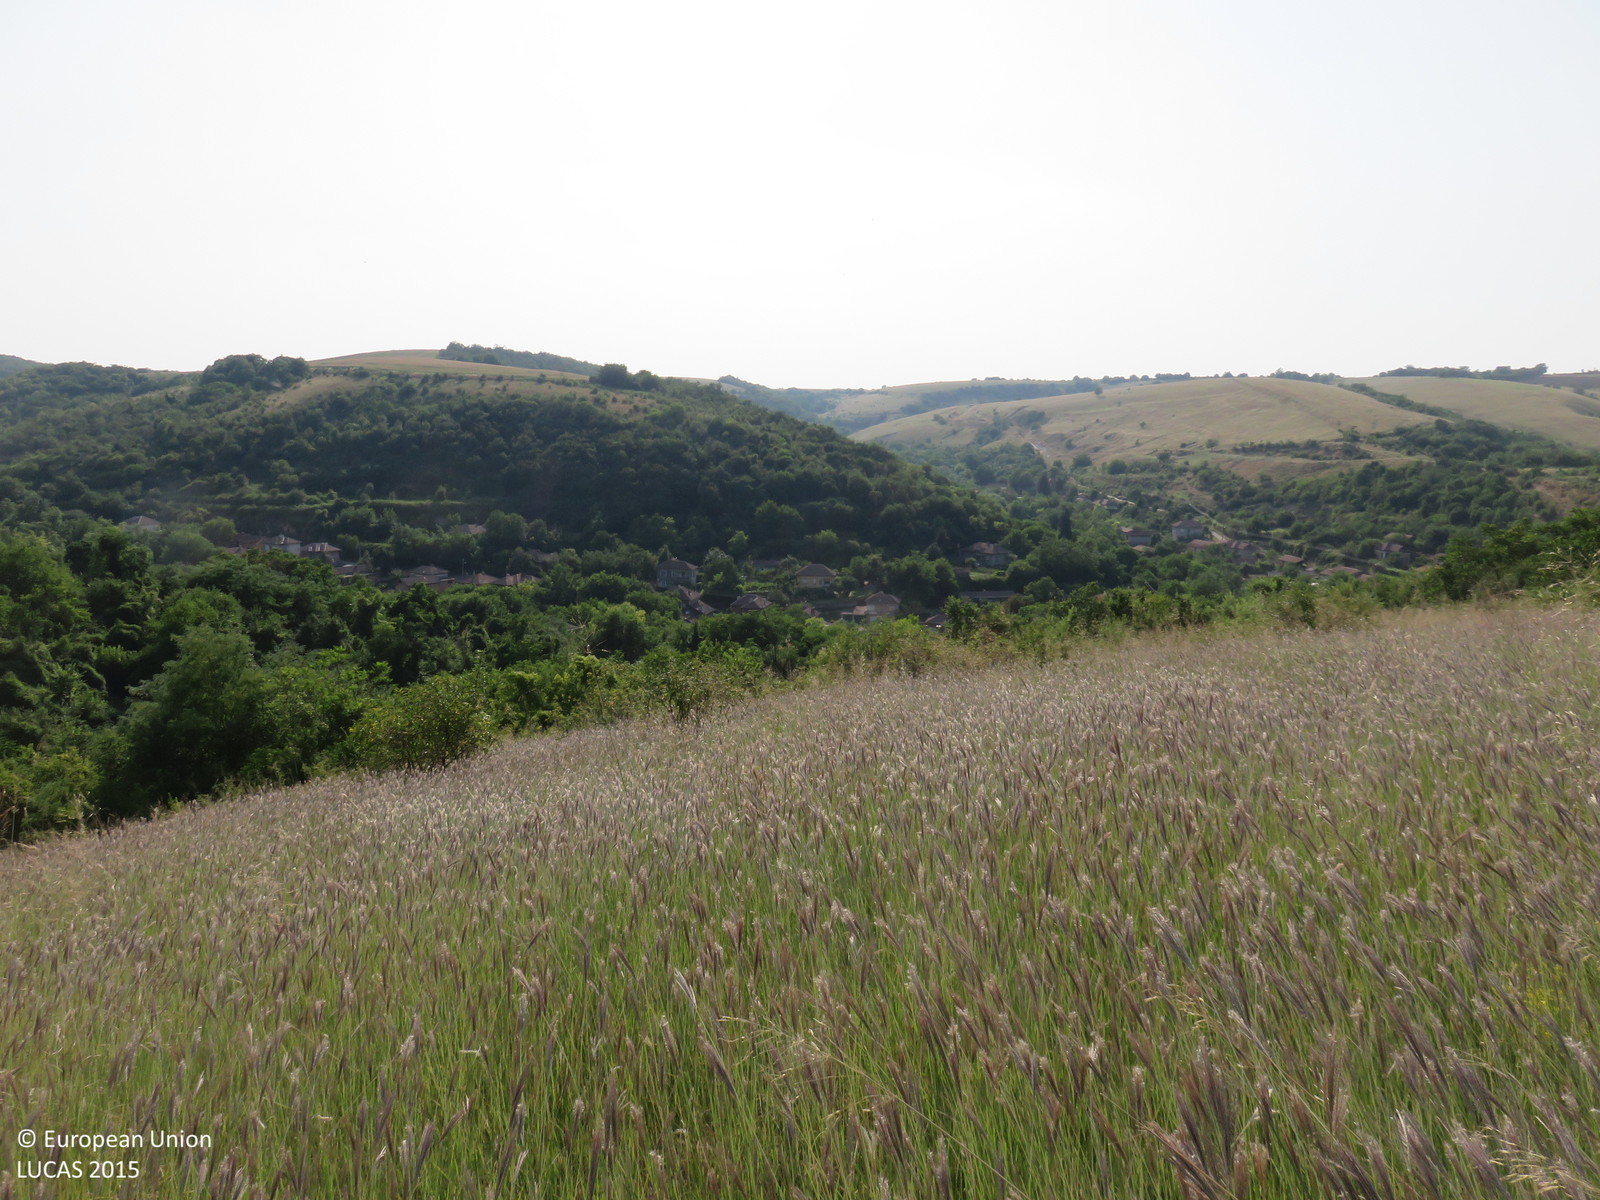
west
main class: Grassland
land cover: Grassland with sparse tree/shrub cover
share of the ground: > 75 %
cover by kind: herbaceous plants 90 %, broadleaved forest trees 5 %, shrubs 5 %
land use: Agriculture (excluding fallow land and kitchen gardens)
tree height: < 5 m
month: July
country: BG
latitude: 43.6010
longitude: 25.0000
